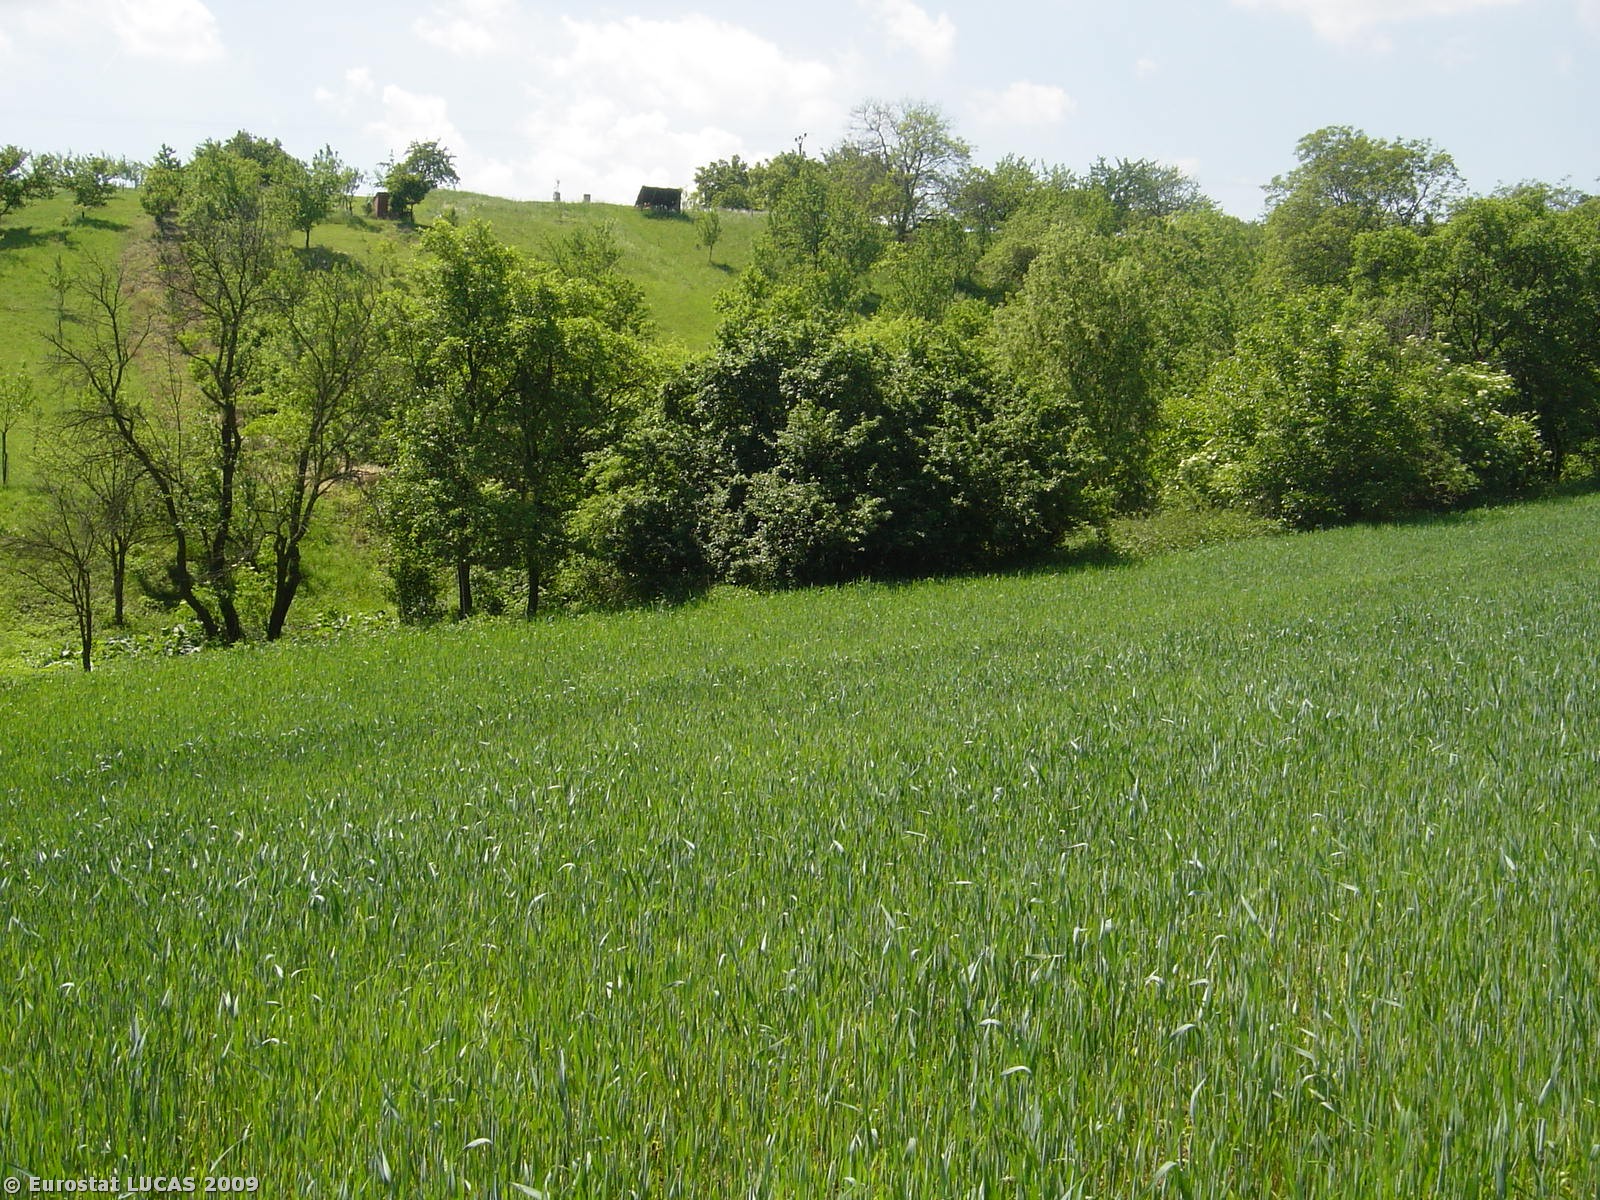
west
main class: Cropland
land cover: Common wheat
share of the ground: > 75 %
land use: Agriculture (excluding fallow land and kitchen gardens)
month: May
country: CZ
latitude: 49.0414
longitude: 17.1095
